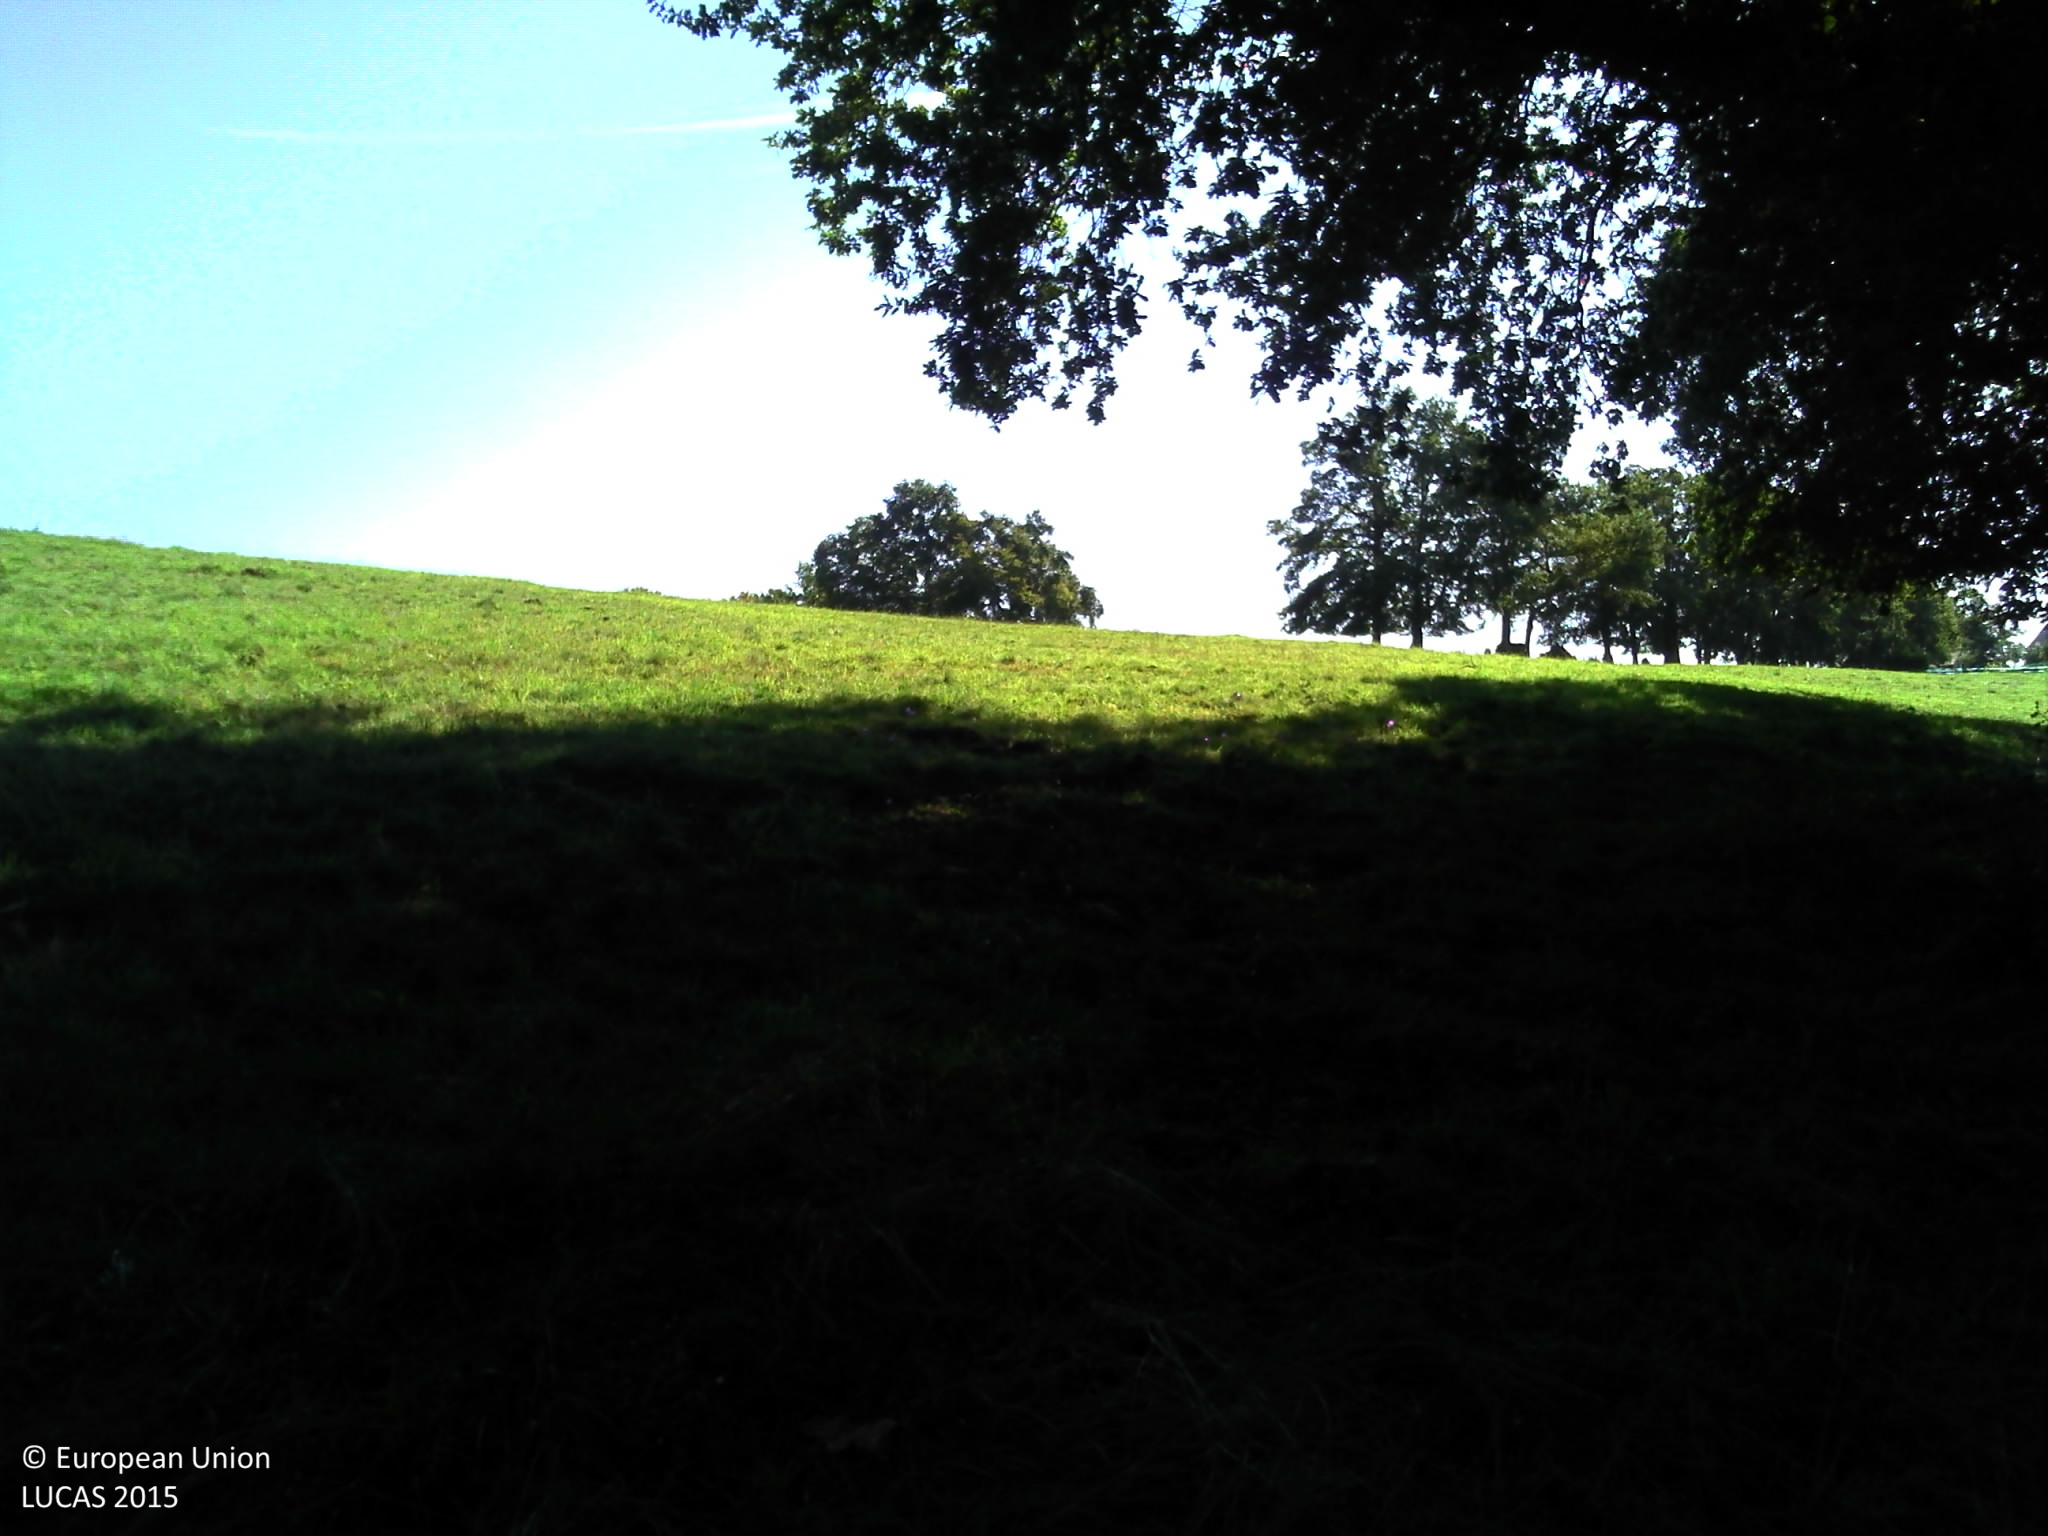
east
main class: Woodland
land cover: Broadleaved woodland
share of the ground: 10 - 25 %
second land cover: Grassland without tree/shrub cover
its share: > 75 %
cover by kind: herbaceous plants 80 %, broadleaved forest trees 20 %
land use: Forestry
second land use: Agriculture (excluding fallow land and kitchen gardens)
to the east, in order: Broadleaved woodland; Grassland without tree/shrub cover; Fences; Broadleaved woodland; Grassland without tree/shrub cover; Broadleaved woodland
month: September
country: FR
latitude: 43.1925
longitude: -0.3794
